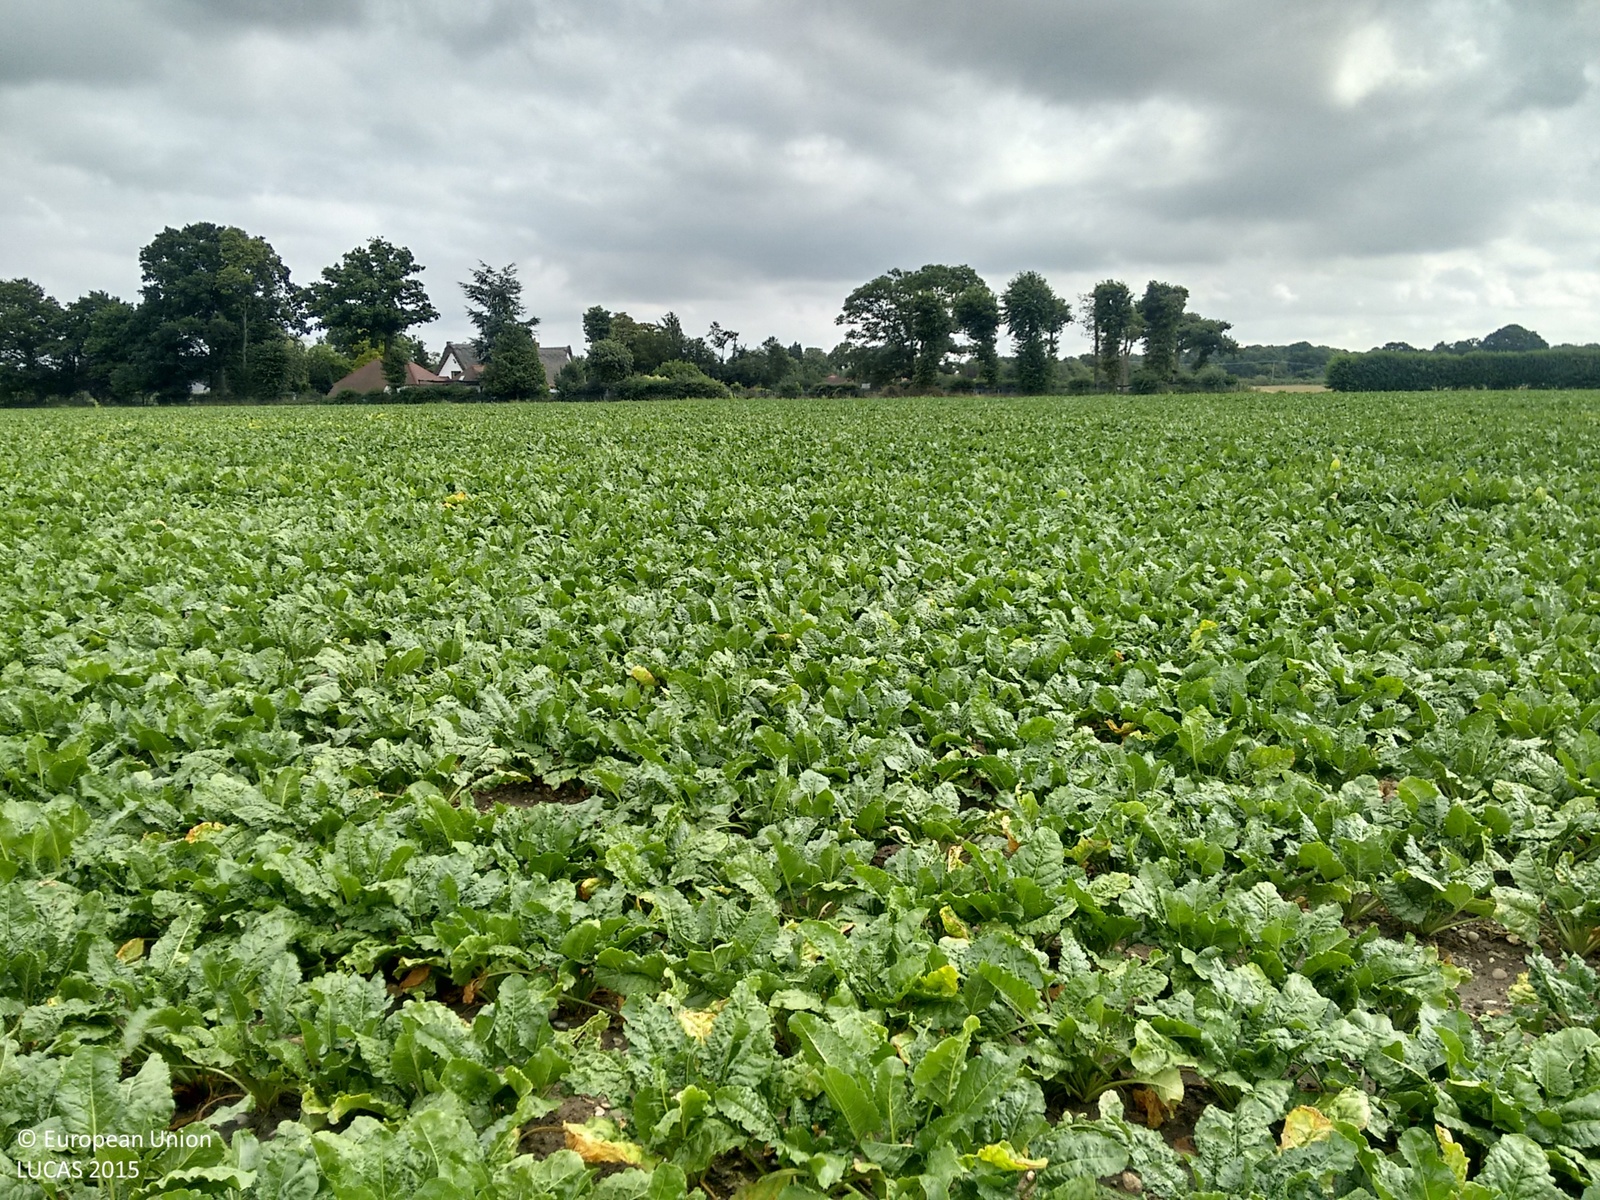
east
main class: Cropland
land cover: Sugar beet
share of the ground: > 75 %
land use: Agriculture (excluding fallow land and kitchen gardens)
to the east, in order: Sugar beet; Grass margins; Artificial constructions in urban areas; Grass margins; Common wheat
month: August
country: GB
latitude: 51.9402
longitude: 0.9429
